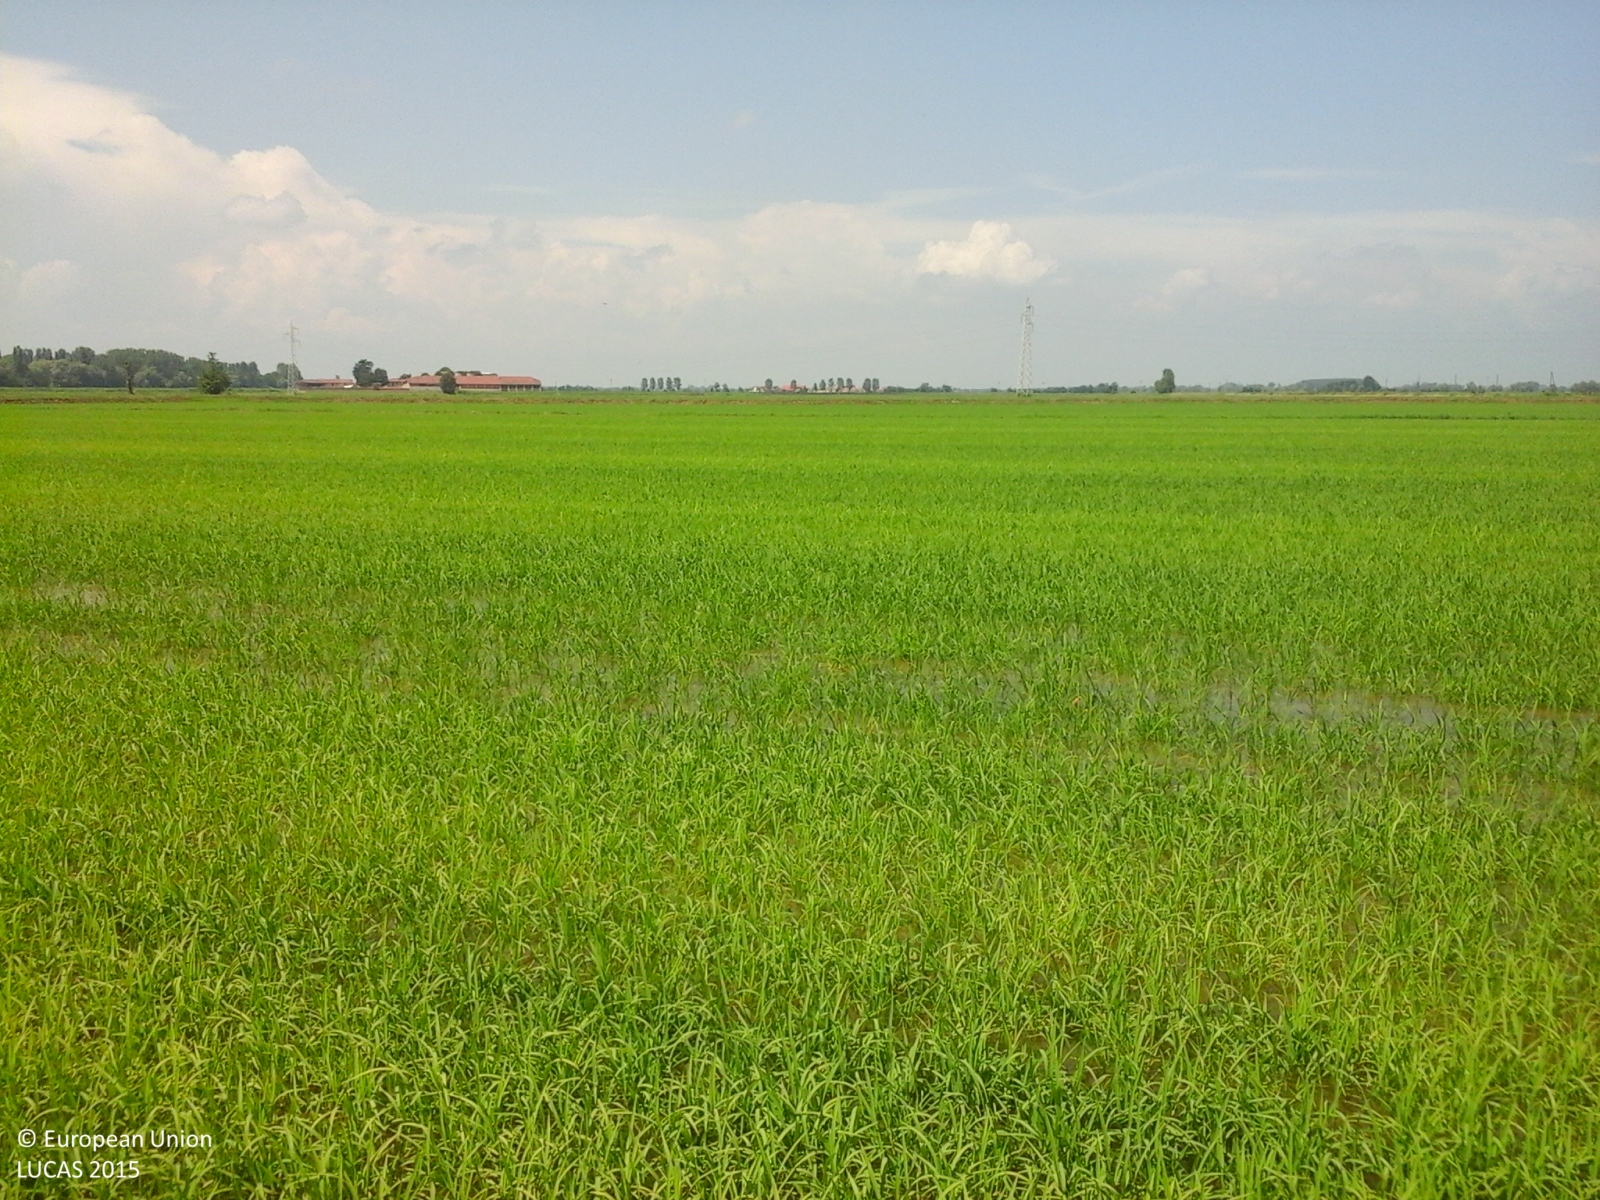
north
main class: Cropland
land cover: Rice
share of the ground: > 75 %
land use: Agriculture (excluding fallow land and kitchen gardens)
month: June
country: IT
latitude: 45.2973
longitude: 8.6379
